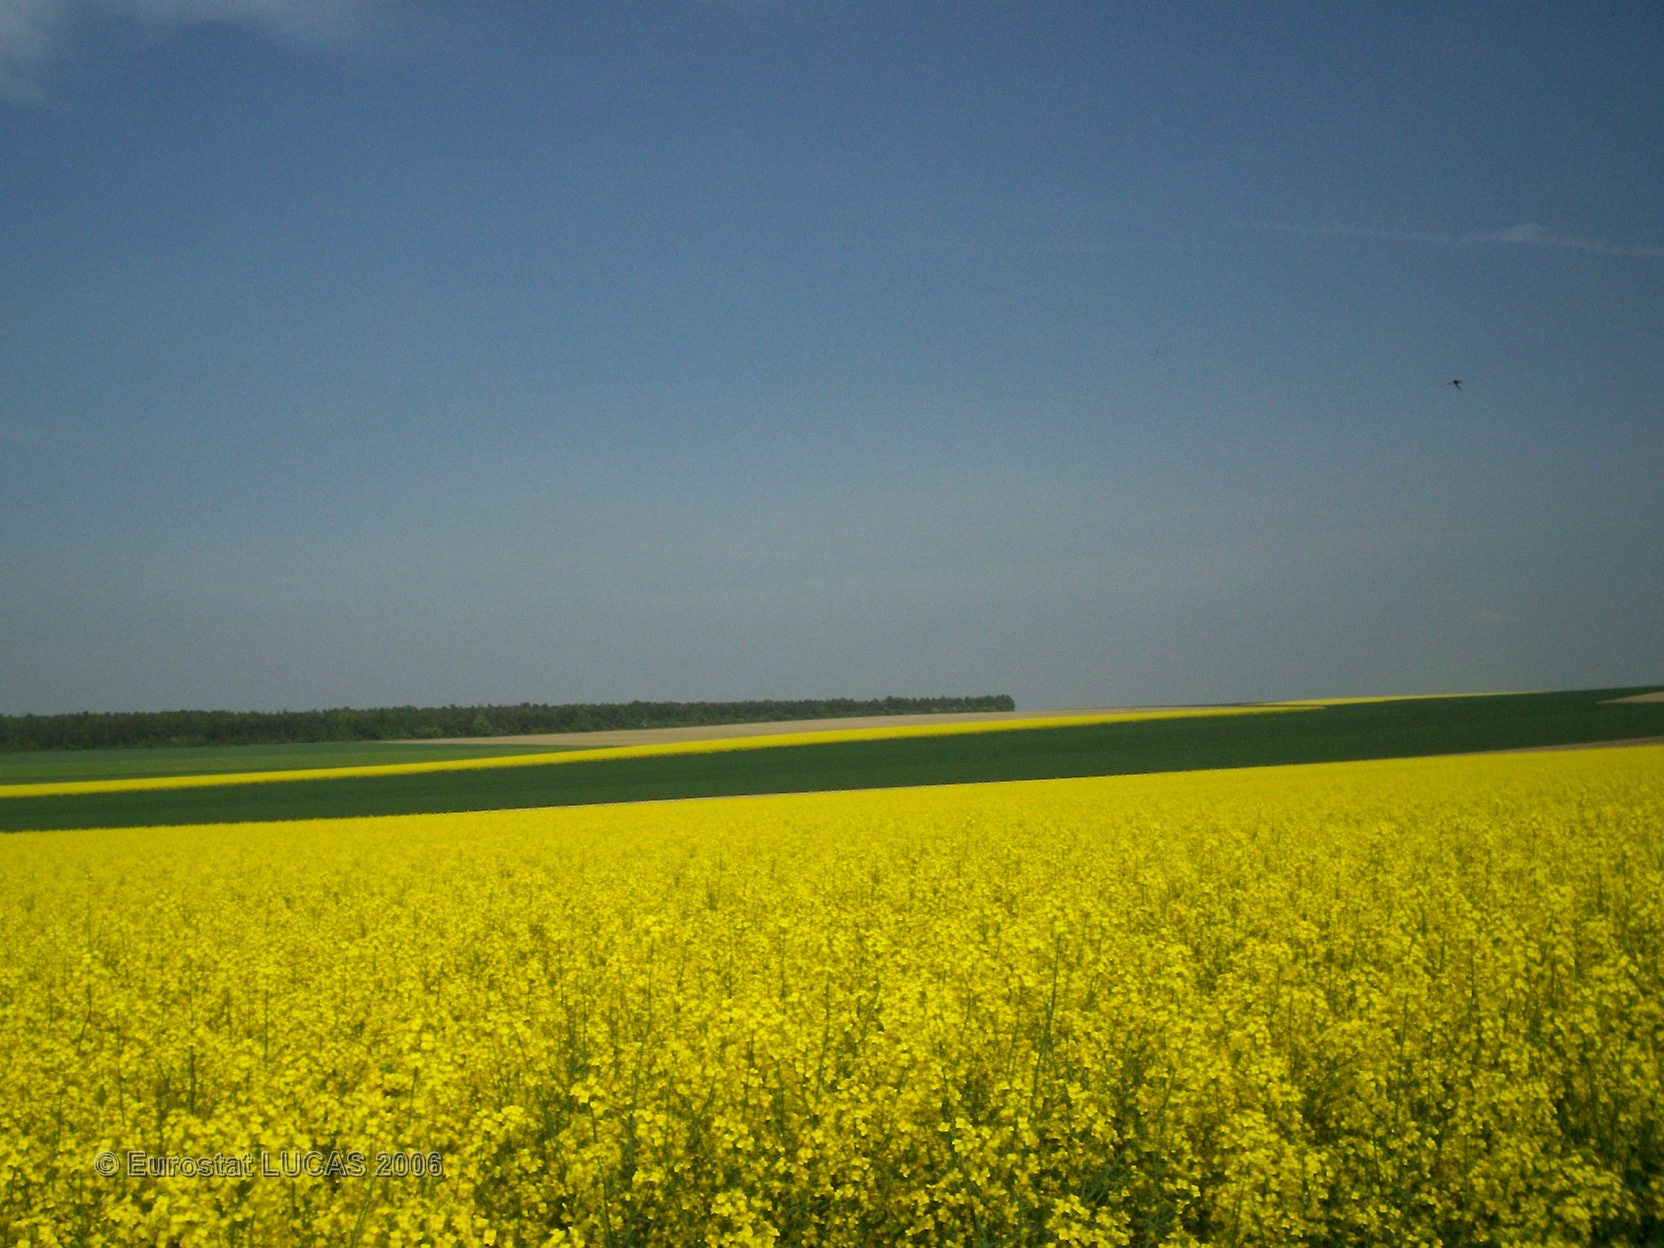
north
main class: Cropland
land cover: Rape and turnip rape
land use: Agriculture (excluding fallow land and kitchen gardens)
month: May
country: FR
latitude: 49.0040
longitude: 4.4602
